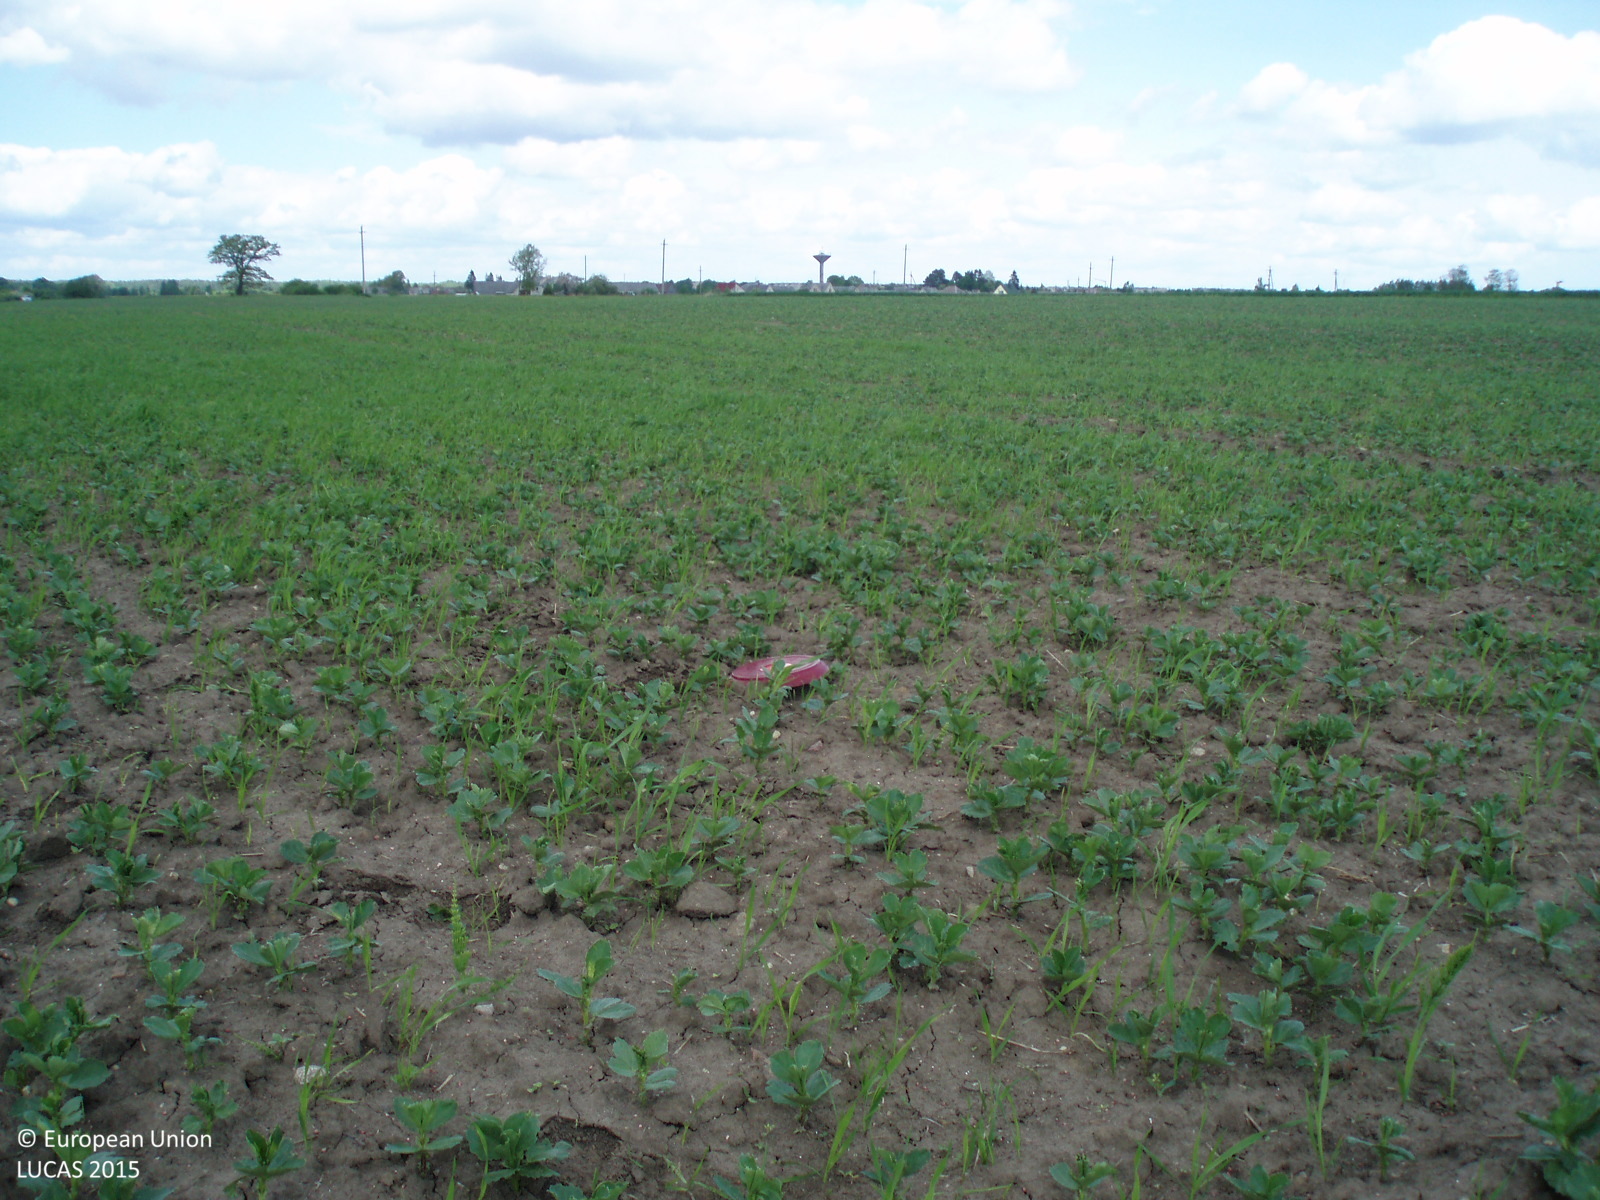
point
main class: Cropland
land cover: Dry pulses
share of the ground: 50 - 75 %
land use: Agriculture (excluding fallow land and kitchen gardens)
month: May
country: LT
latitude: 56.1758
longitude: 22.6740
